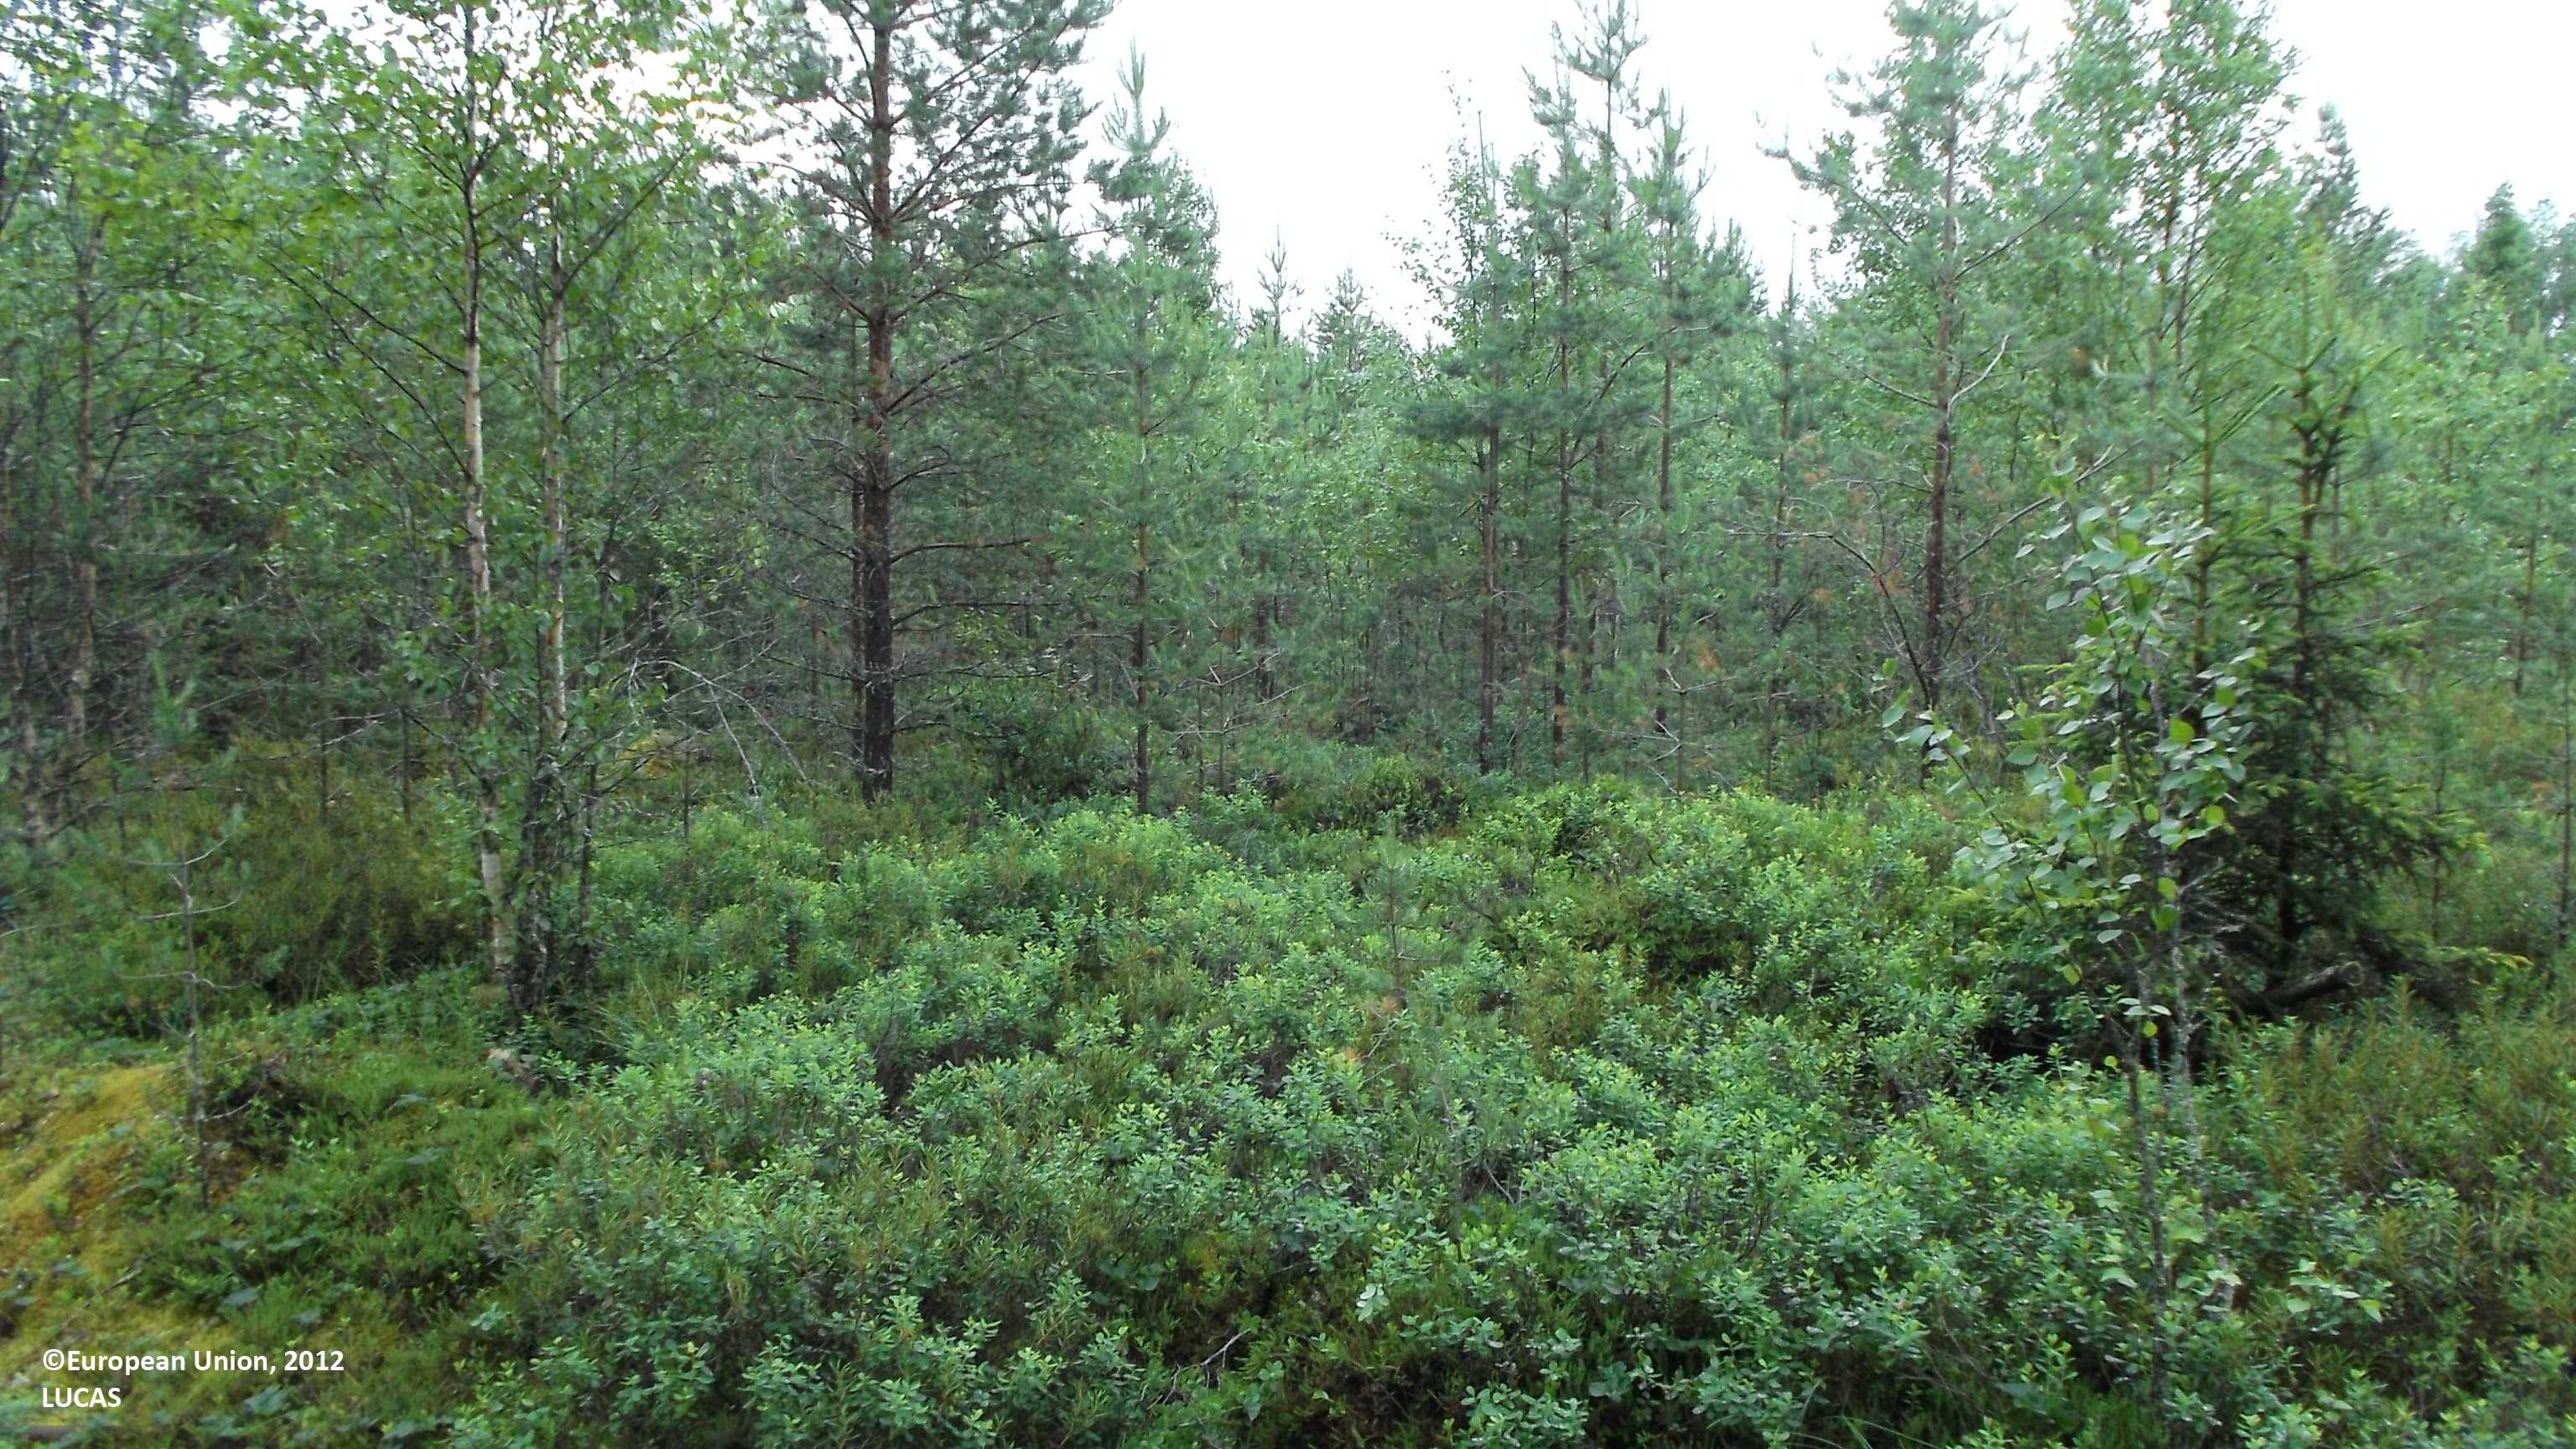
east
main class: Woodland
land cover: Other mixed woodland
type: boreal forest
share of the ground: 50 - 75 %
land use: Forestry
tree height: > 5 m
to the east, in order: Other mixed woodland; Pine dominated mixed woodland; Ditches and canals; Other mixed woodland; Spruce dominated mixed woodland
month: July
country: FI
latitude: 63.3928
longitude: 23.9394
